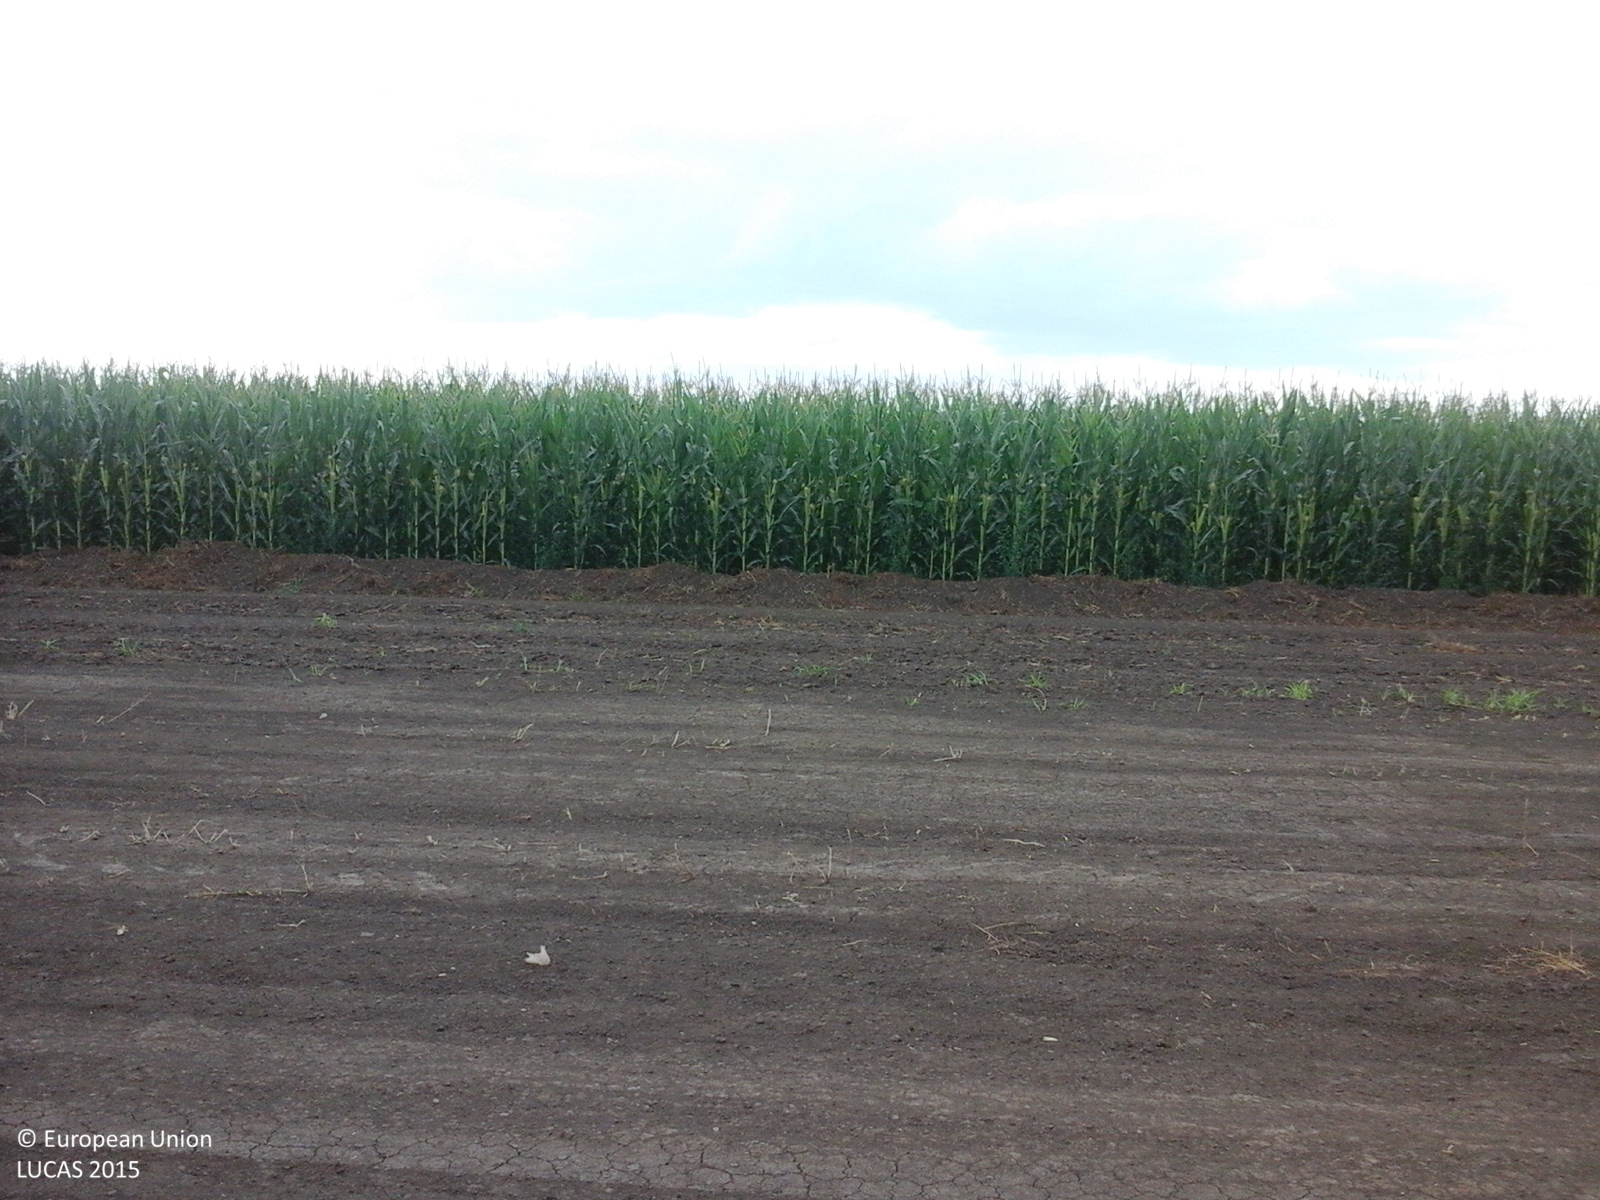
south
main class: Cropland
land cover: Maize
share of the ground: > 75 %
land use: Agriculture (excluding fallow land and kitchen gardens)
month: July
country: RO
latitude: 43.8401
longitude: 25.2410
